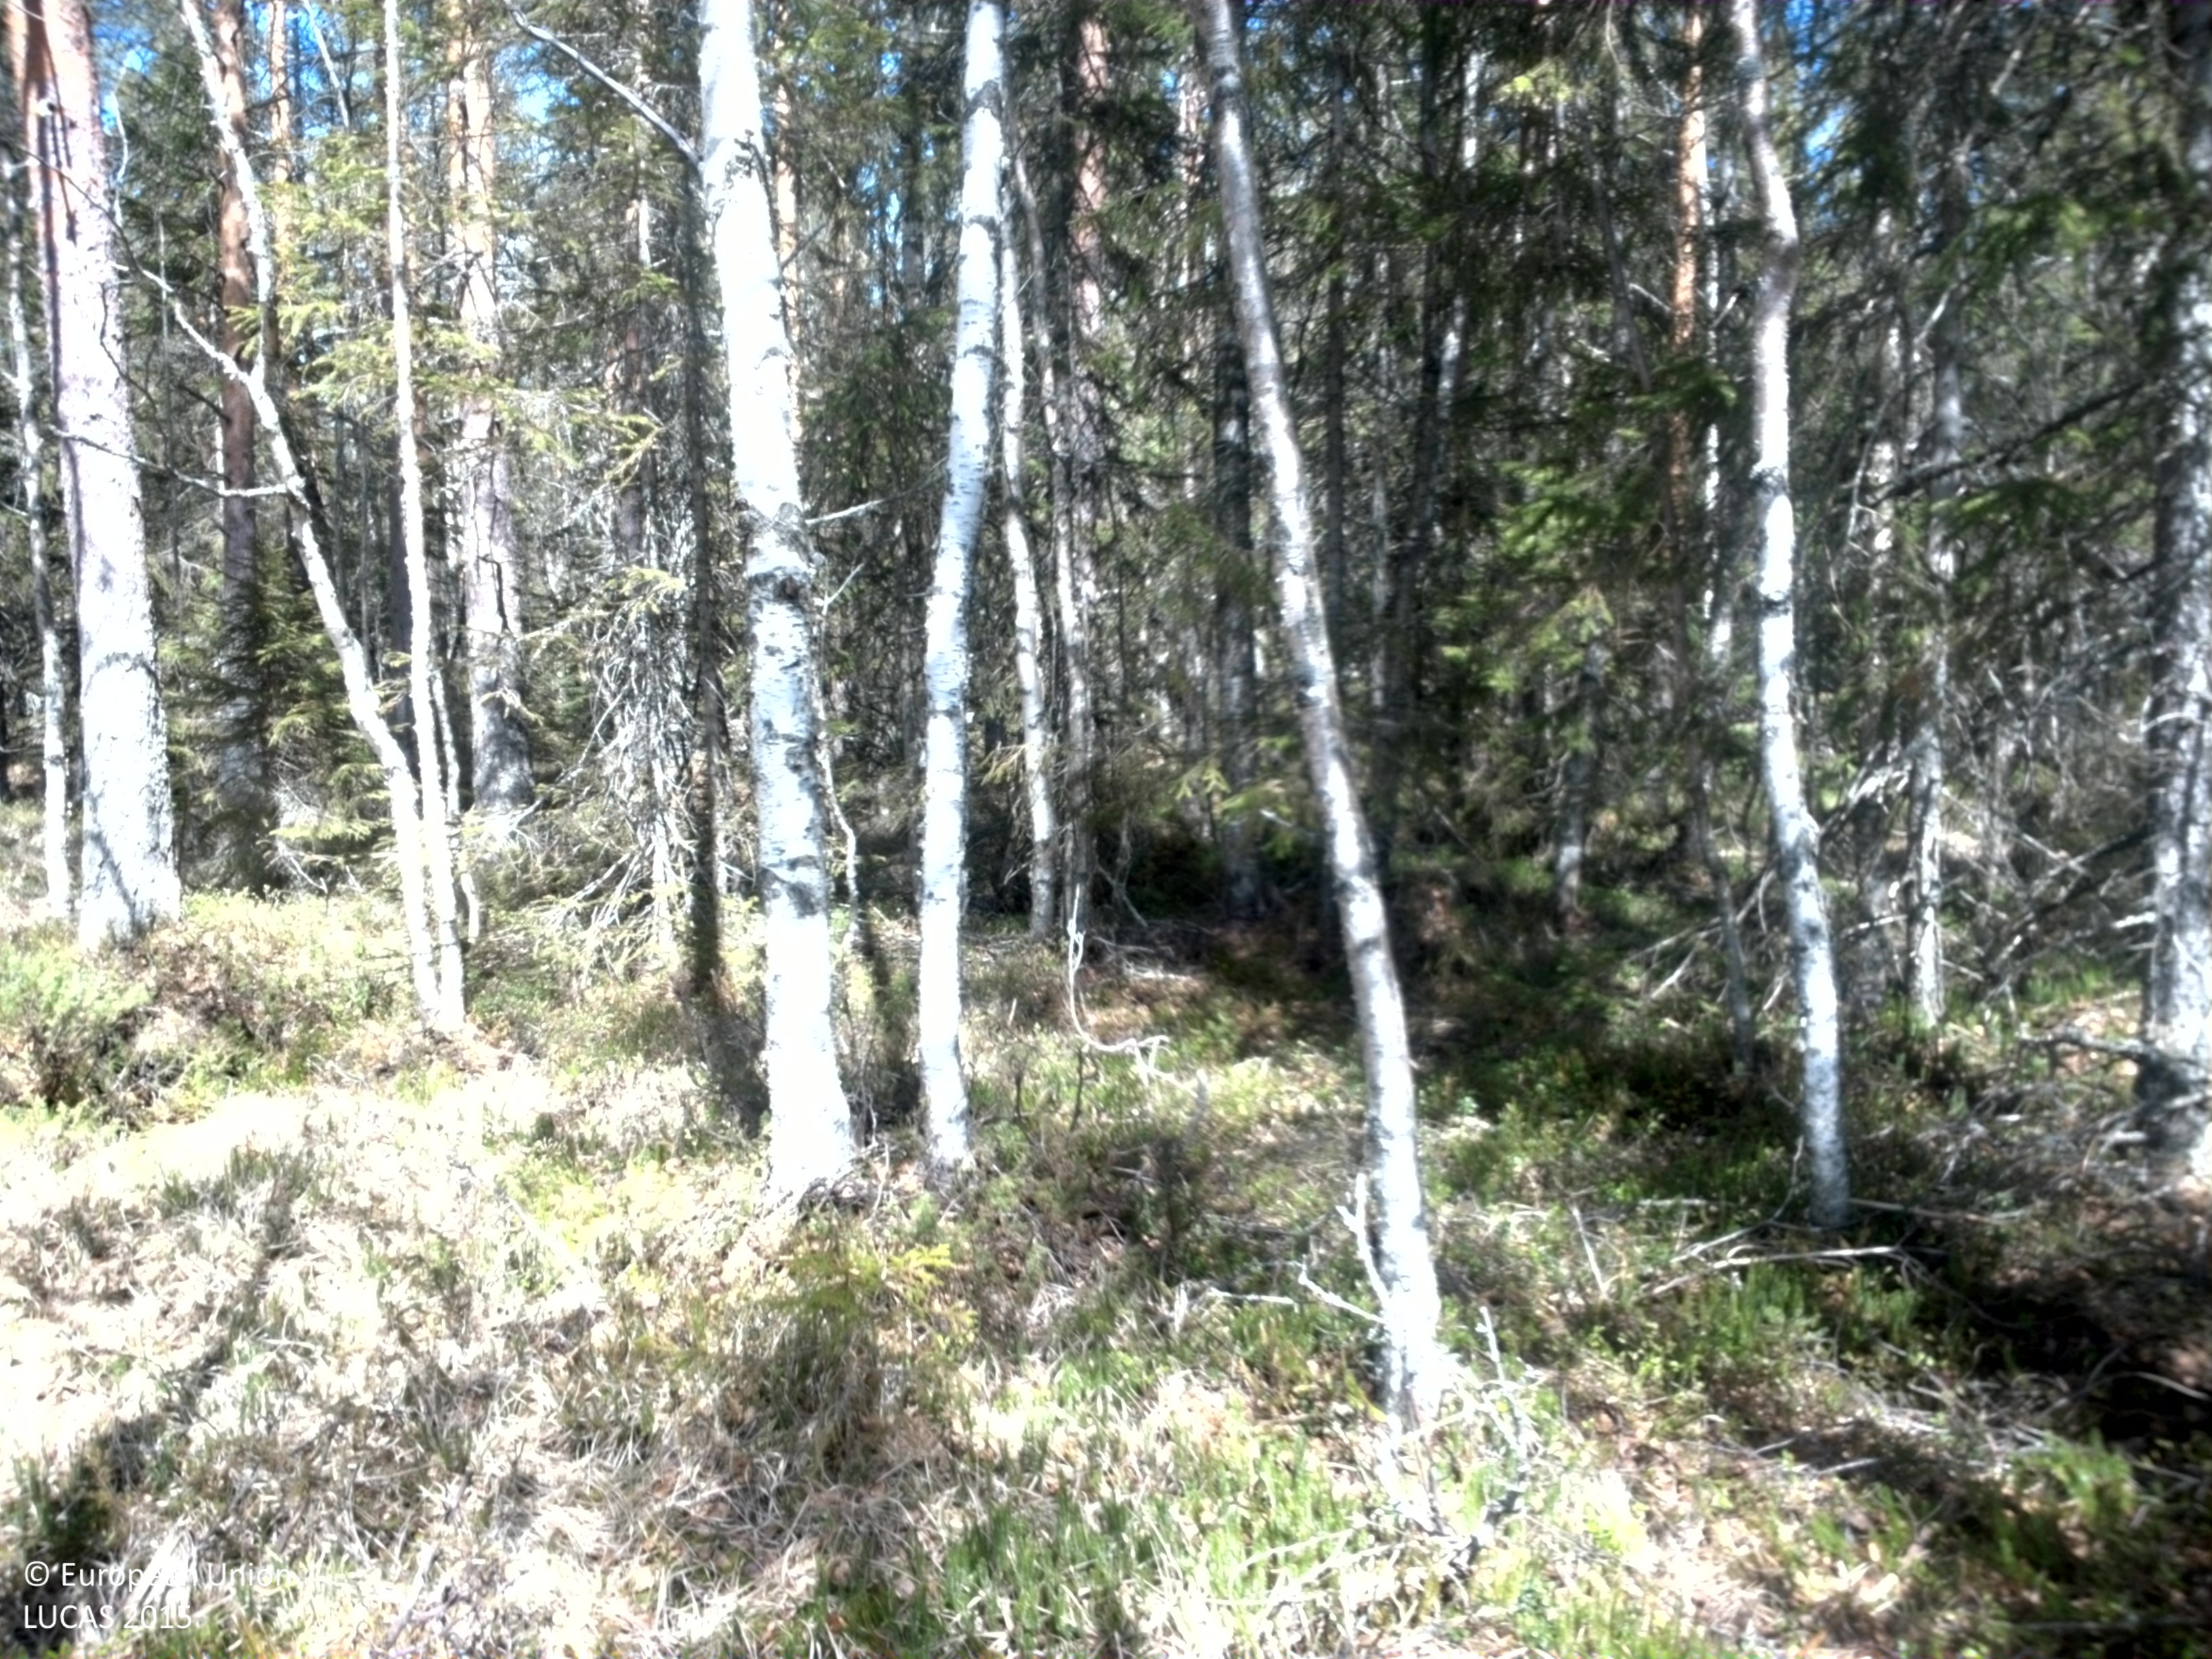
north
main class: Woodland
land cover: Pine dominated mixed woodland
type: boreal forest
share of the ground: 50 - 75 %
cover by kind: coniferous forest trees 50 %, broadleaved forest trees 25 %, herbaceous plants 15 %, shrubs 10 %
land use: Forestry
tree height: > 5 m
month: June
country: SE
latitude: 61.2041
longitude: 13.3569
